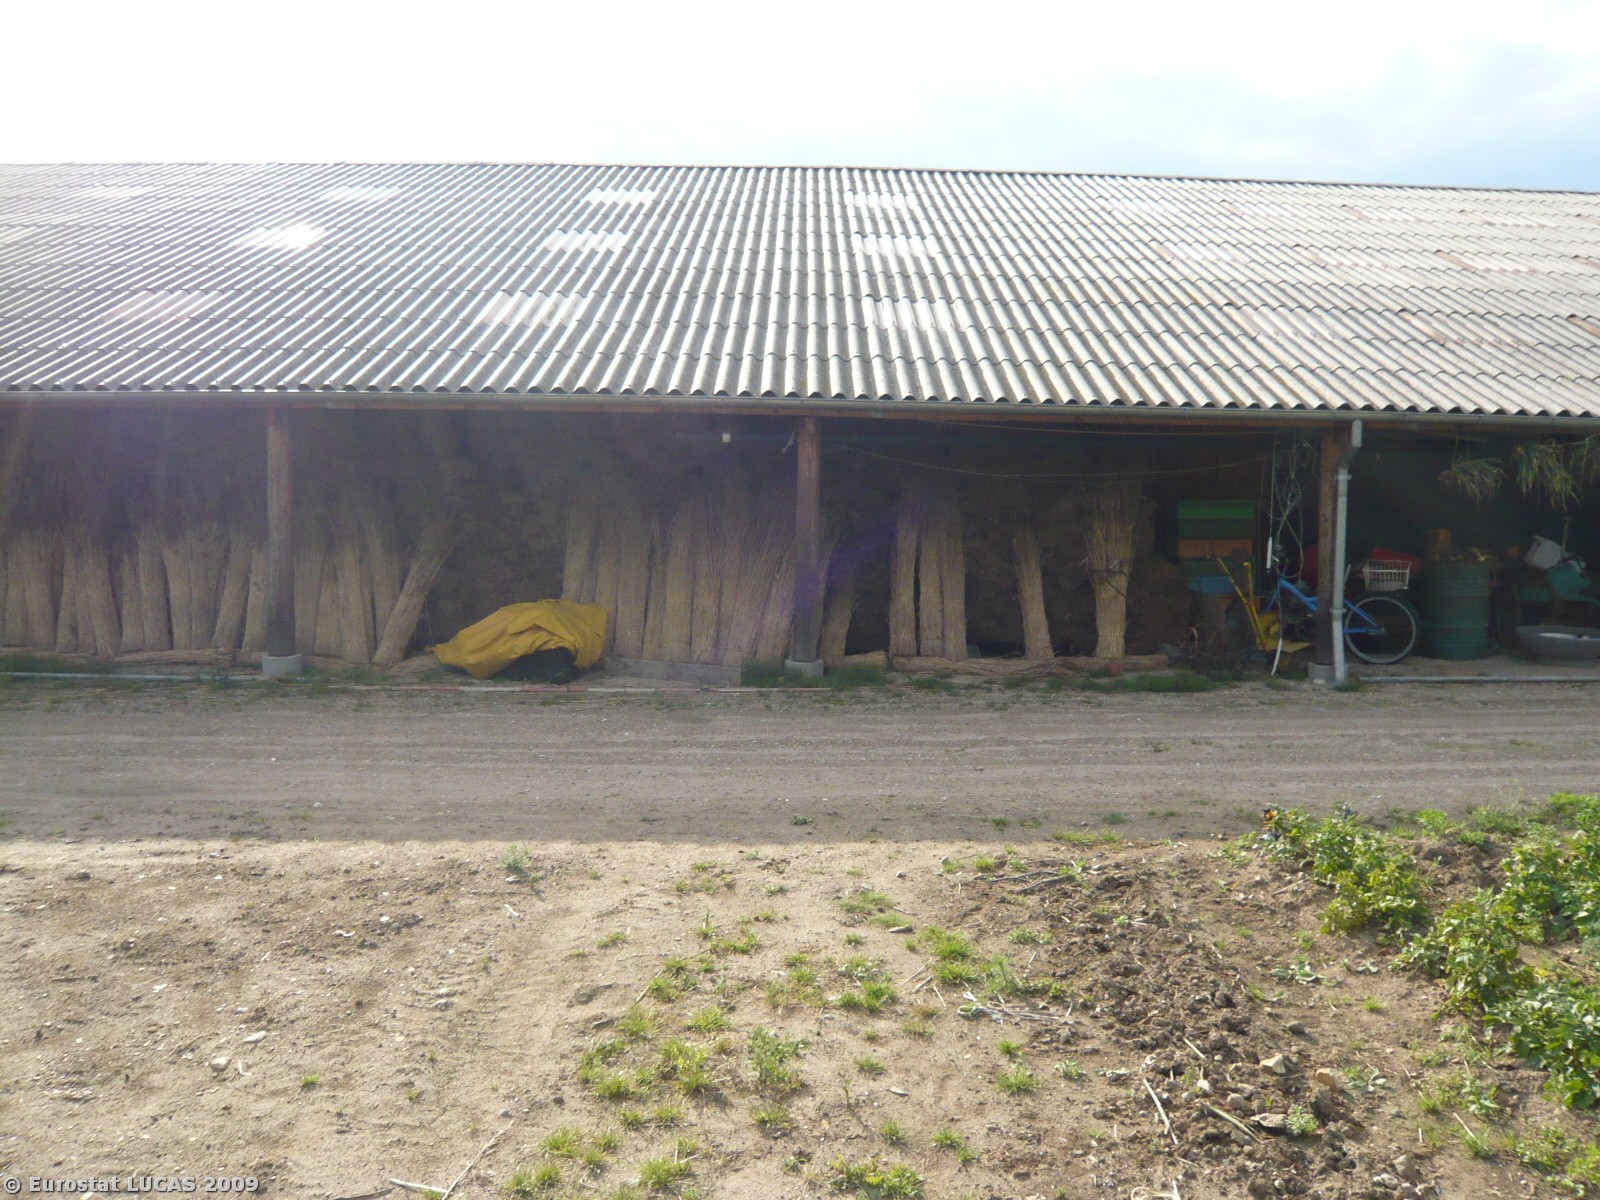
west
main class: Cropland
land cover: Barley
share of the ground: < 10 %
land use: Agriculture (excluding fallow land and kitchen gardens)
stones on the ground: 10 - 25 %
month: May
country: DK
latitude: 55.2974
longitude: 11.5580
